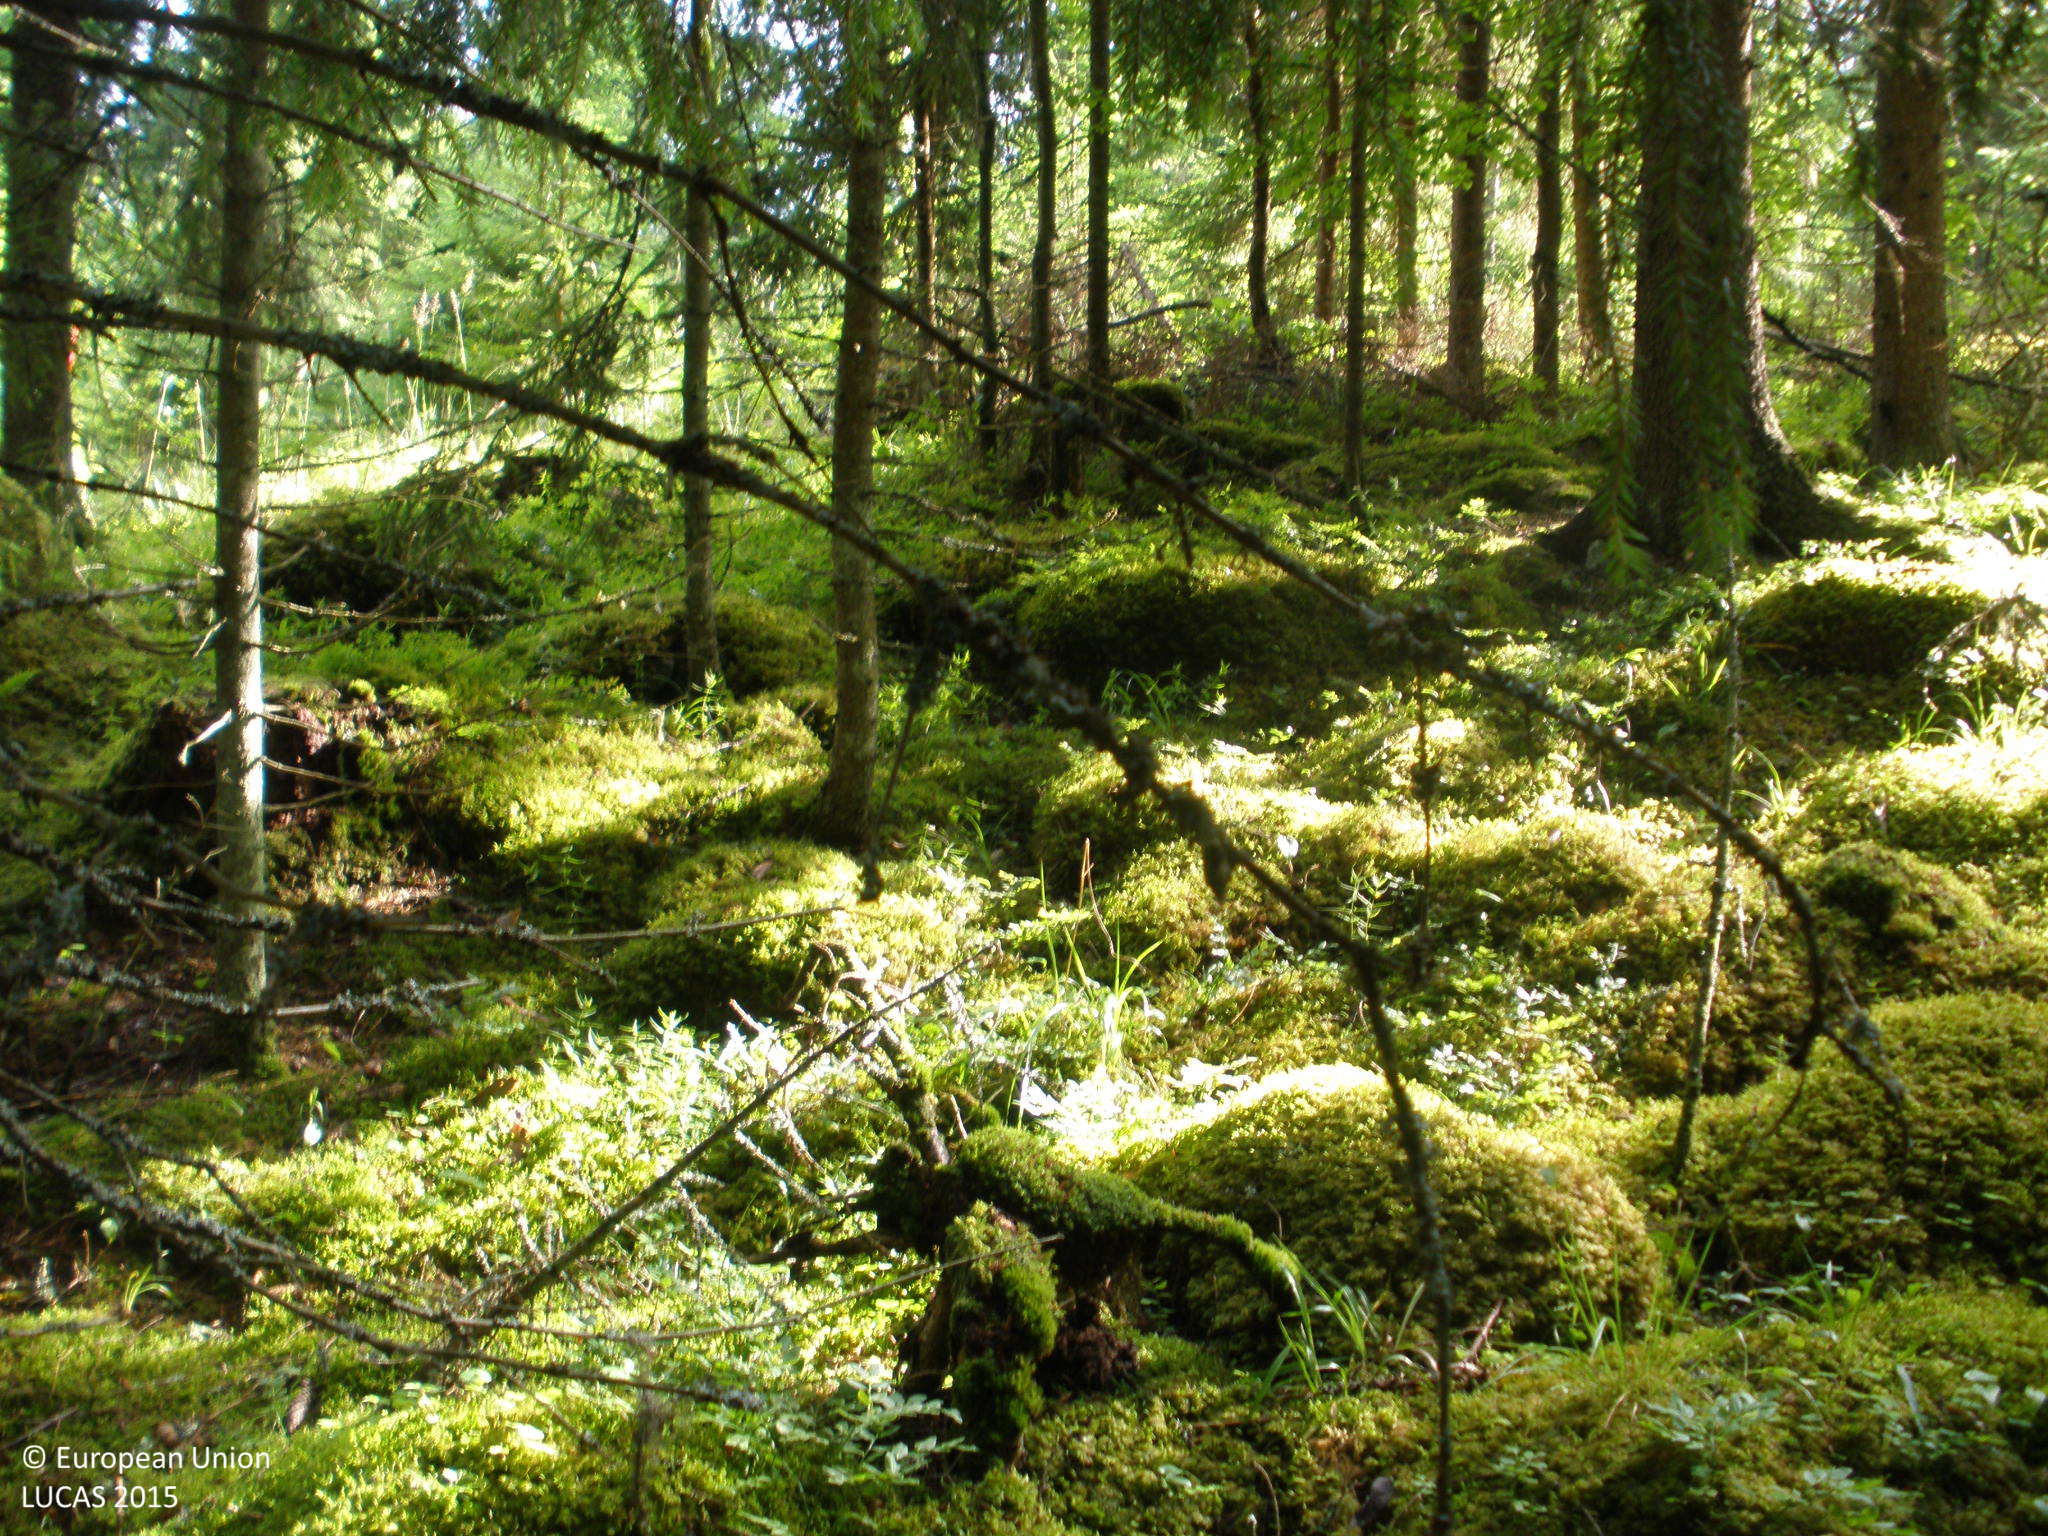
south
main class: Woodland
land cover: Spruce dominated coniferous woodland
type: boreal forest
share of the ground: > 75 %
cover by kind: coniferous forest trees 90 %, herbaceous plants 5 %, lichens and mosses 5 %
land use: Forestry
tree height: > 5 m
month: July
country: FI
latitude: 61.2558
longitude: 24.7387
